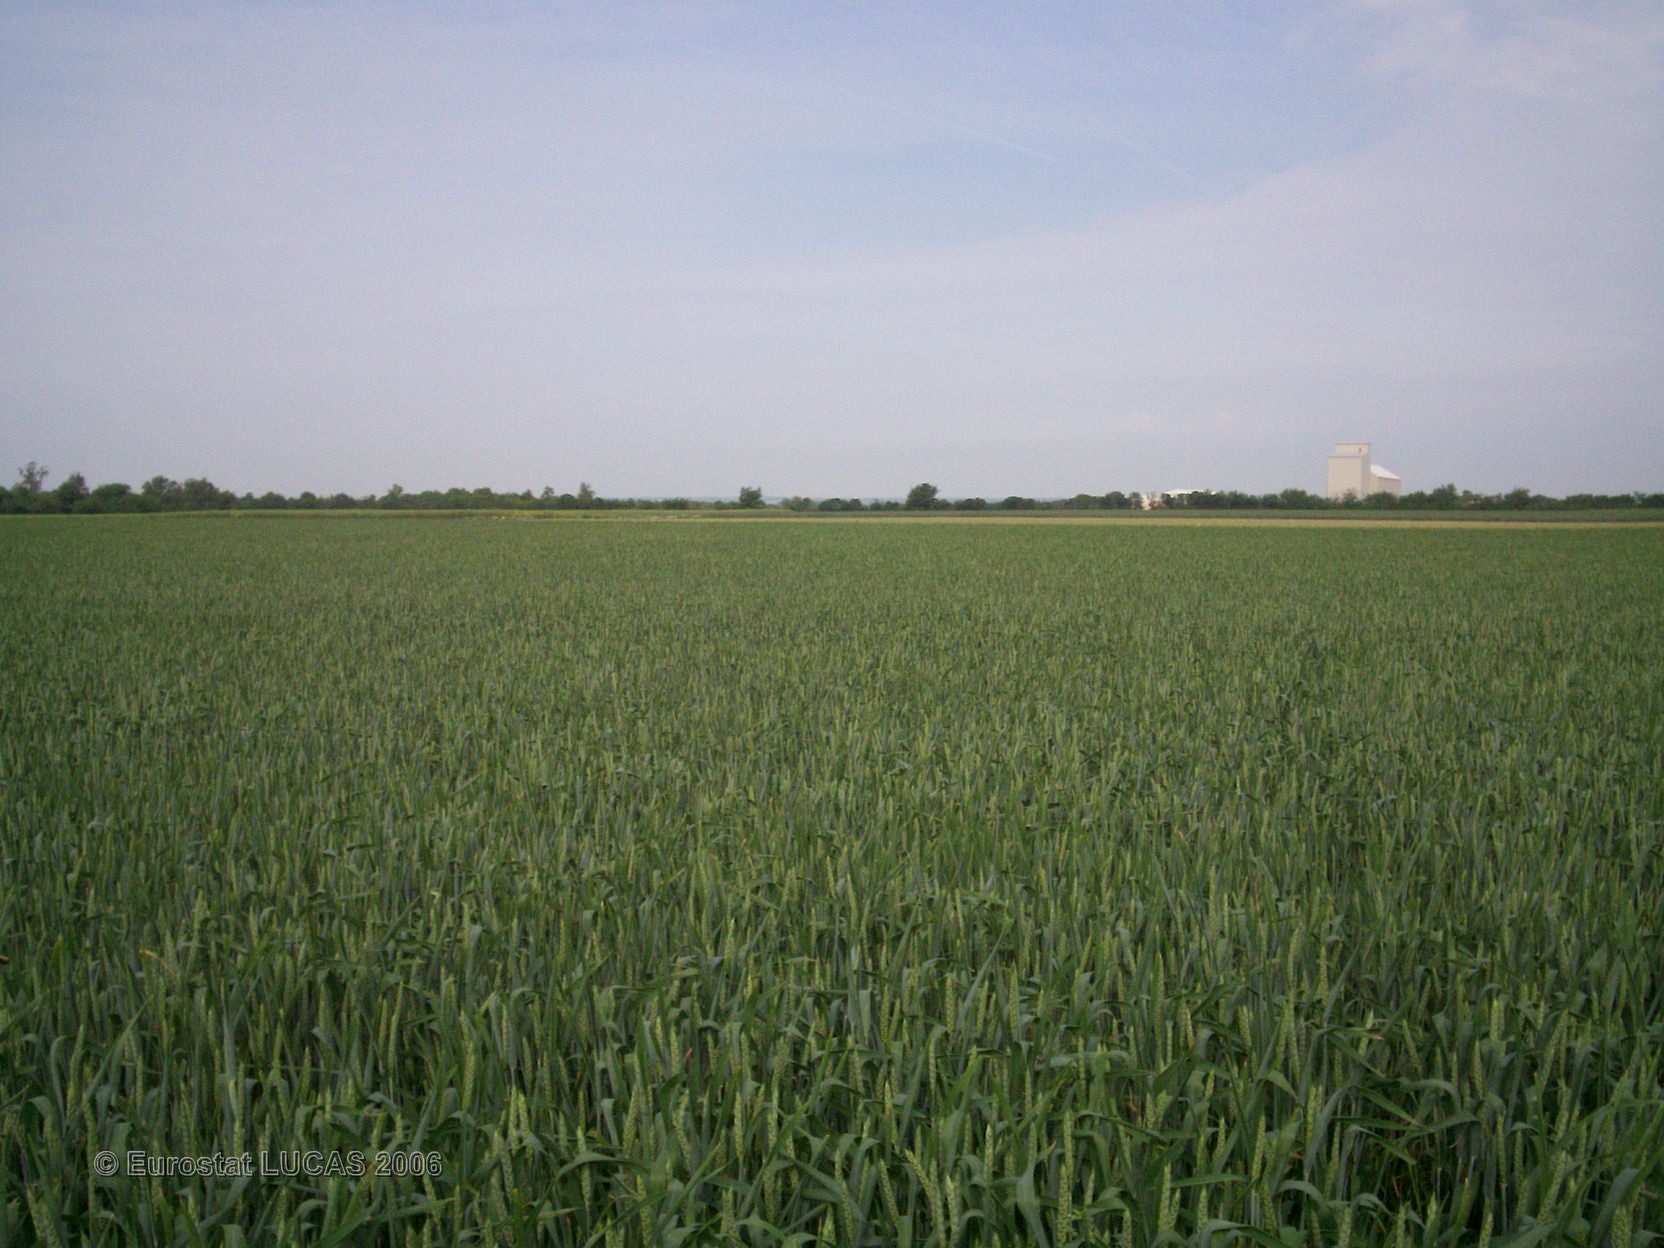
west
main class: Cropland
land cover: Rape and turnip rape
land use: Agriculture (excluding fallow land and kitchen gardens)
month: May
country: FR
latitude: 46.1135
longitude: -0.2309
